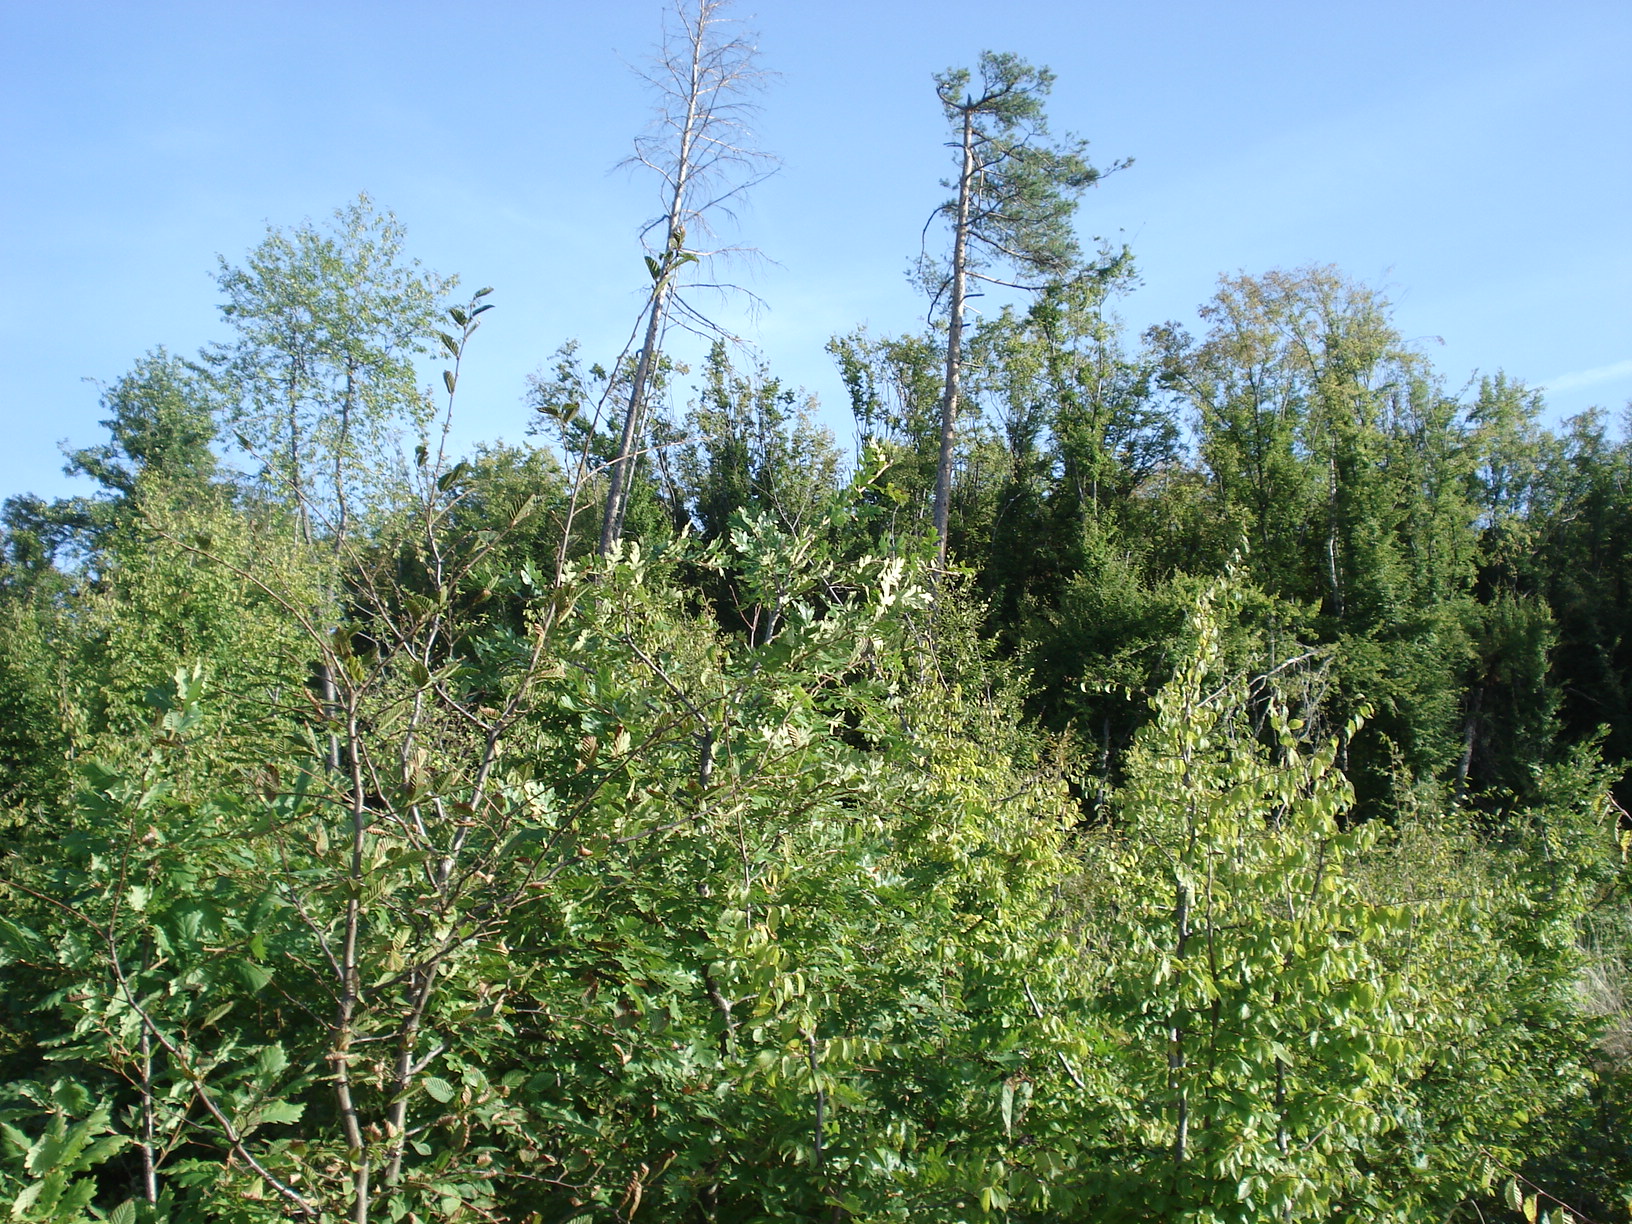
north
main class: Woodland
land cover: Pine dominated mixed woodland
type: hemiboreal forest and nemoral coniferous forest and mixed broadleaved-coniferous forest
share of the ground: 50 - 75 %
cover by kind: coniferous forest trees 35 %, broadleaved forest trees 35 %, shrubs 20 %, herbaceous plants 10 %
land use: Forestry
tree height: < 5 m
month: September
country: BG
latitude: 42.9224
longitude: 25.7248
